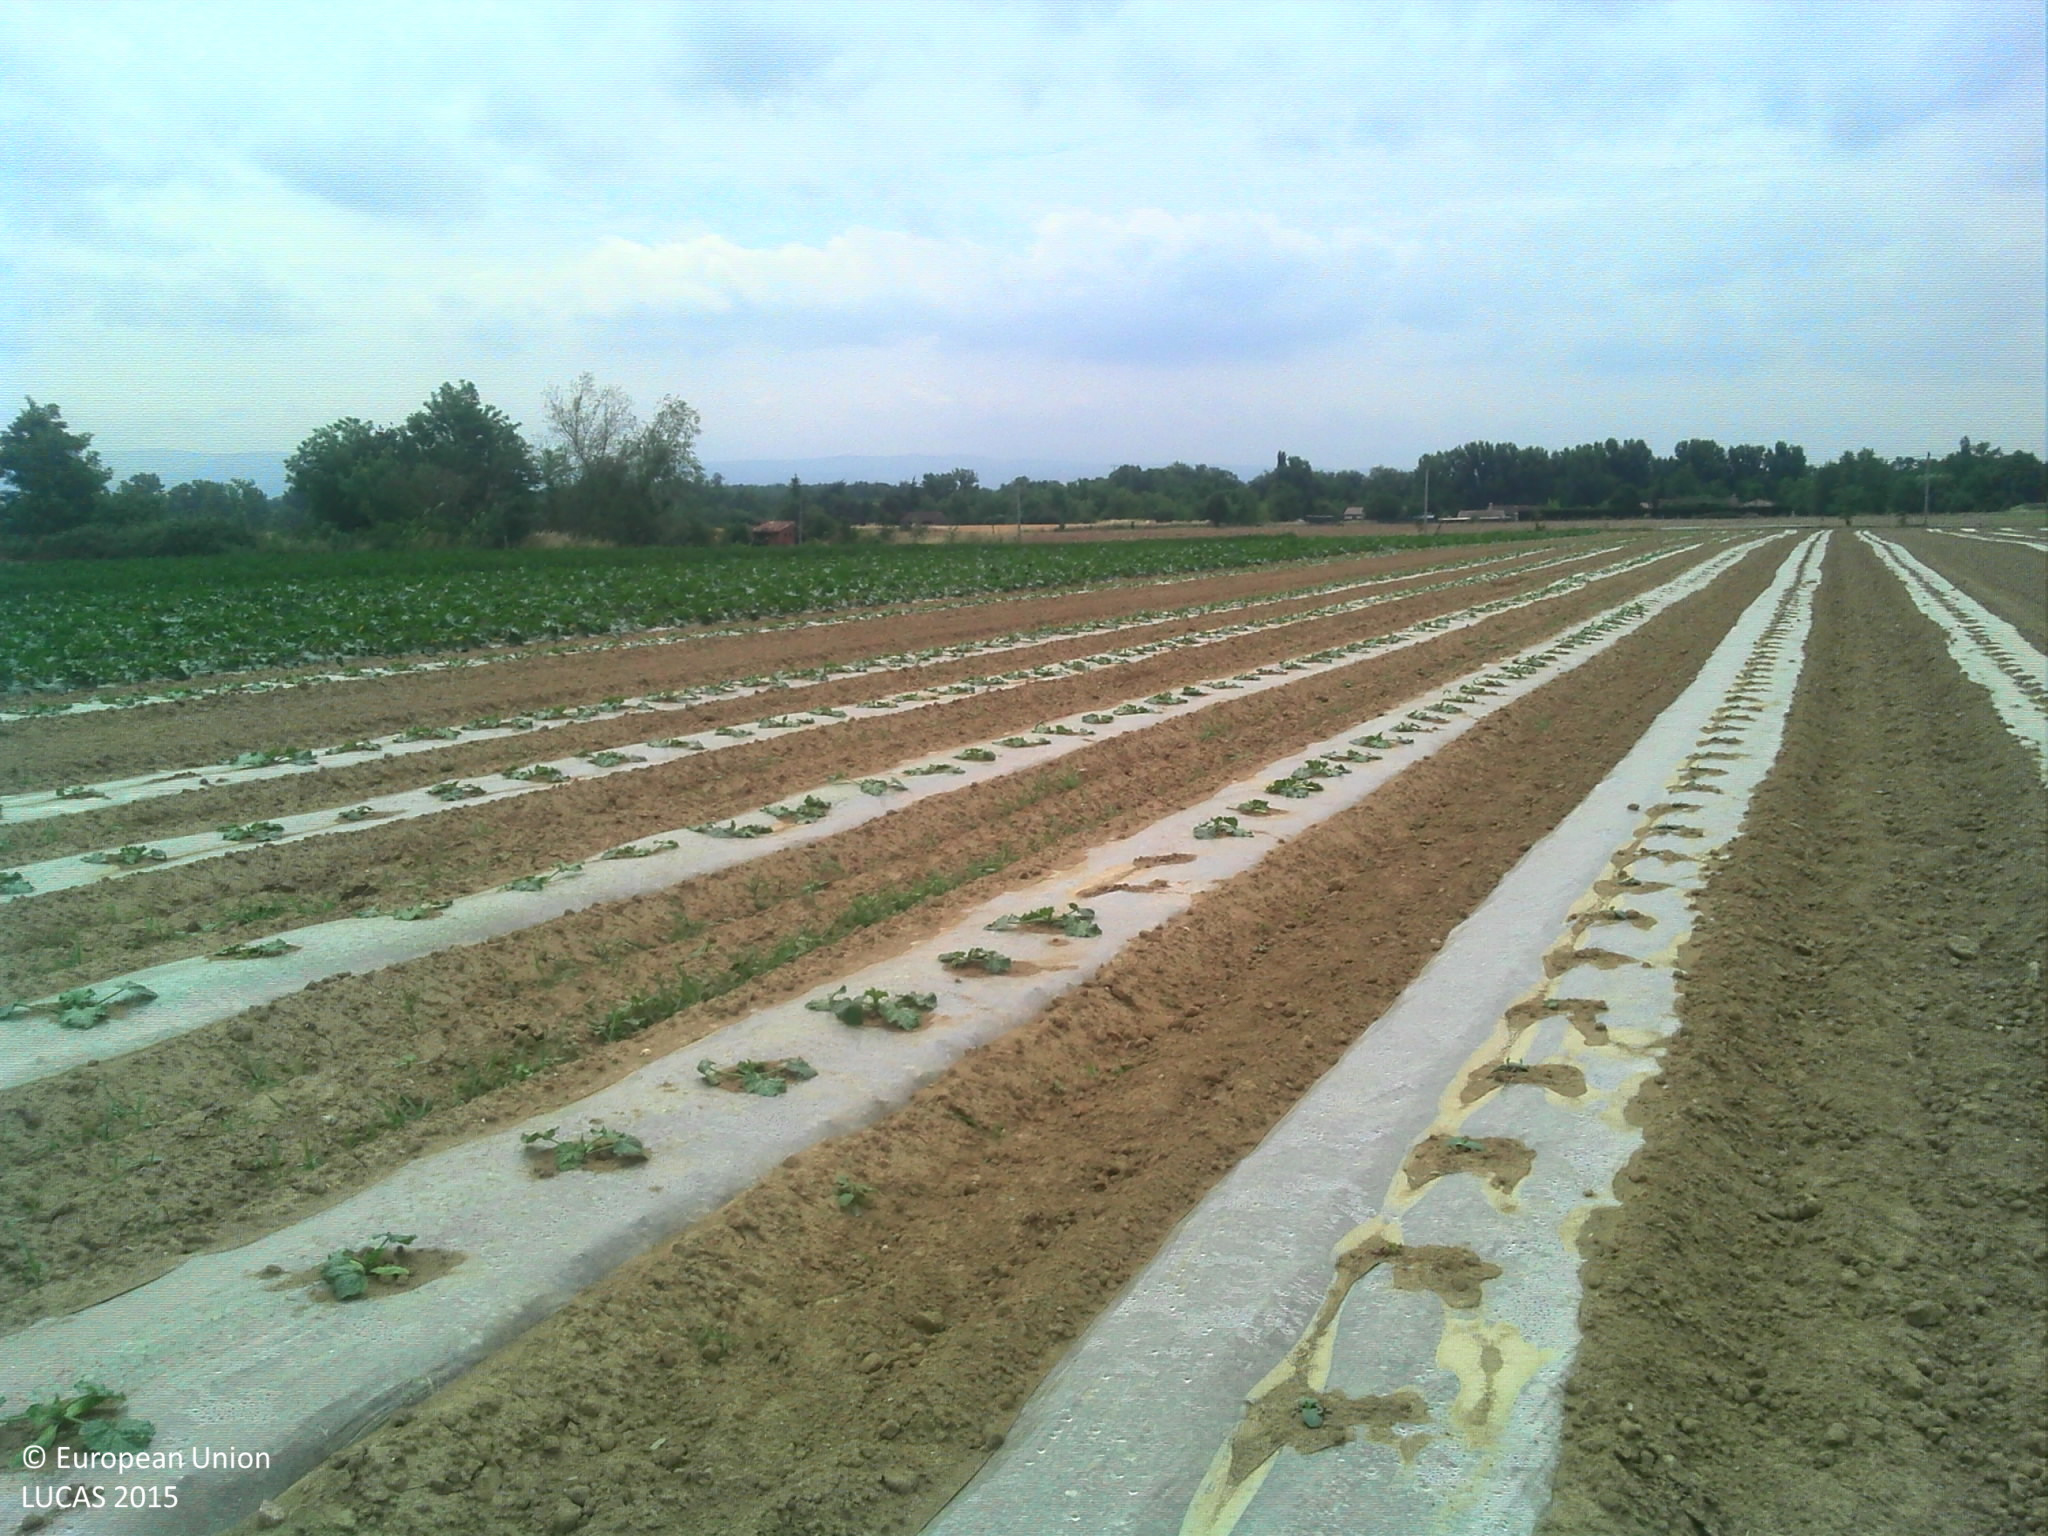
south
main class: Cropland
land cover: Other fresh vegetables
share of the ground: < 10 %
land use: Agriculture (excluding fallow land and kitchen gardens)
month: June
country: FR
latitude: 43.5991
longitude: 2.1392
